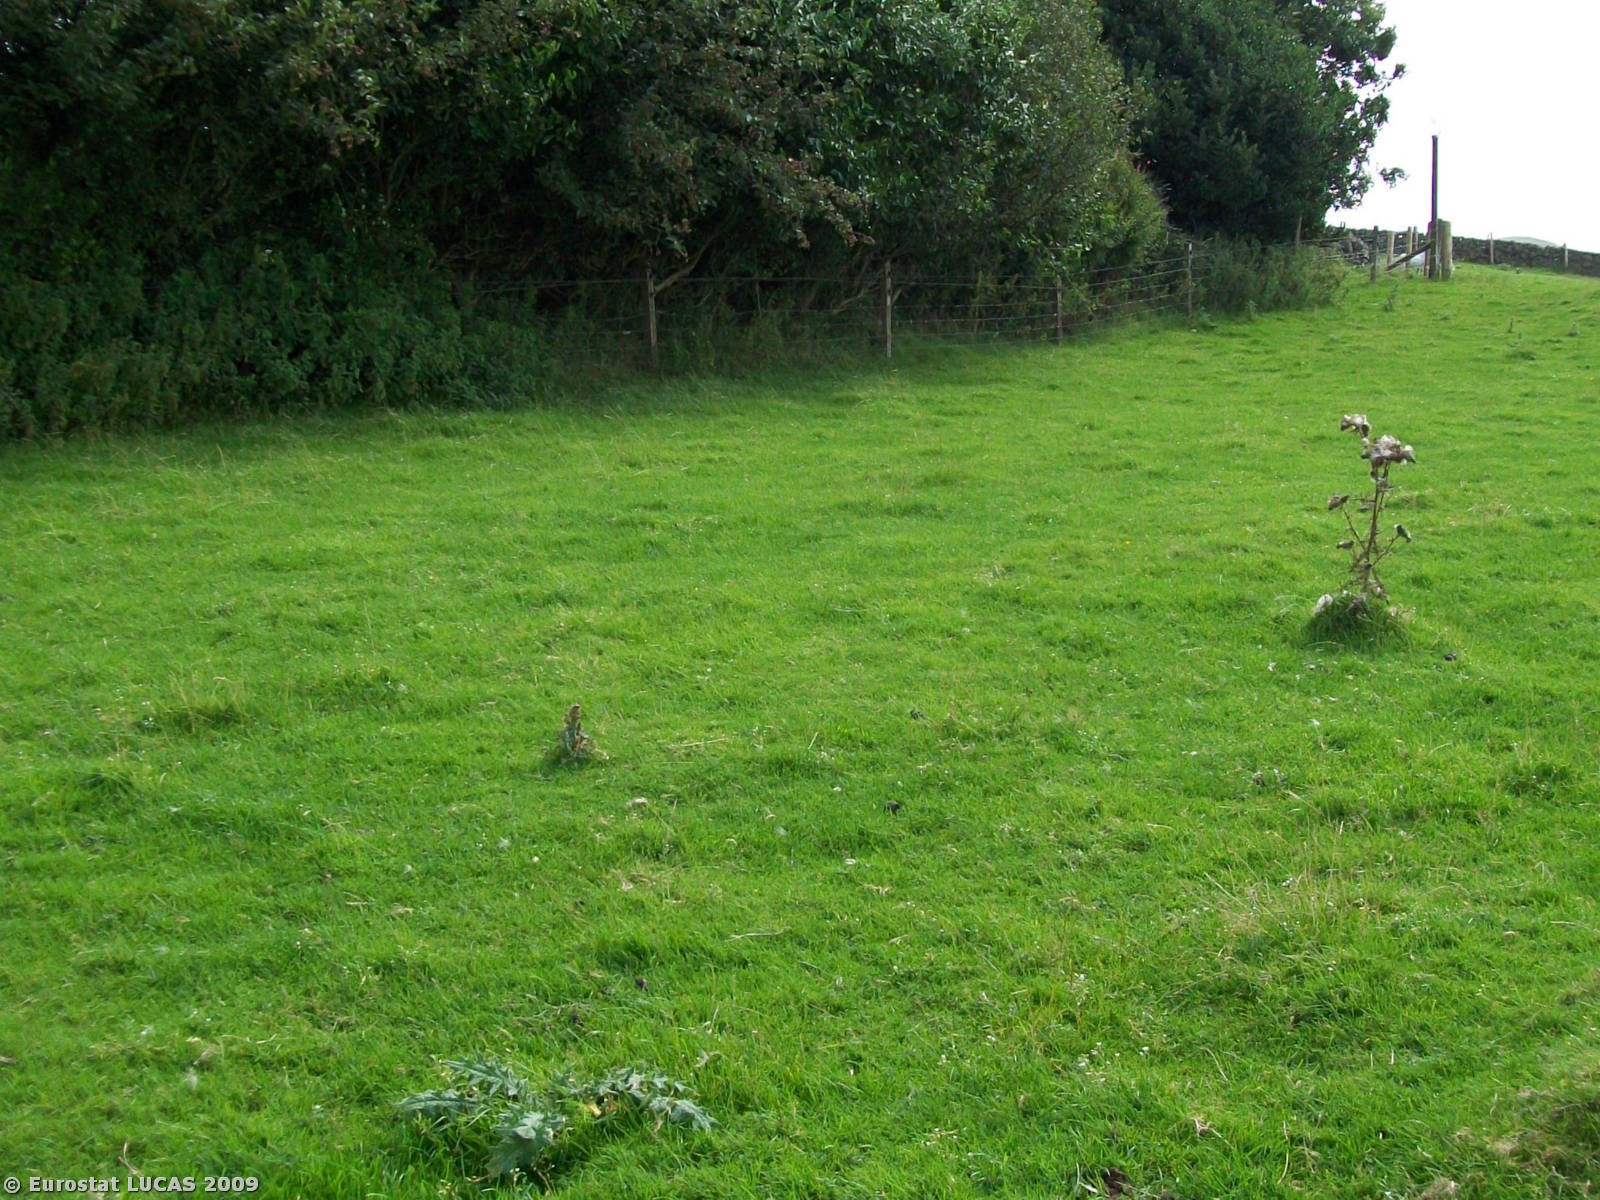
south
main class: Grassland
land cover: Grassland without tree/shrub cover
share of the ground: < 10 %
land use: Agriculture (excluding fallow land and kitchen gardens)
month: August
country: GB
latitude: 54.8932
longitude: -4.7163
